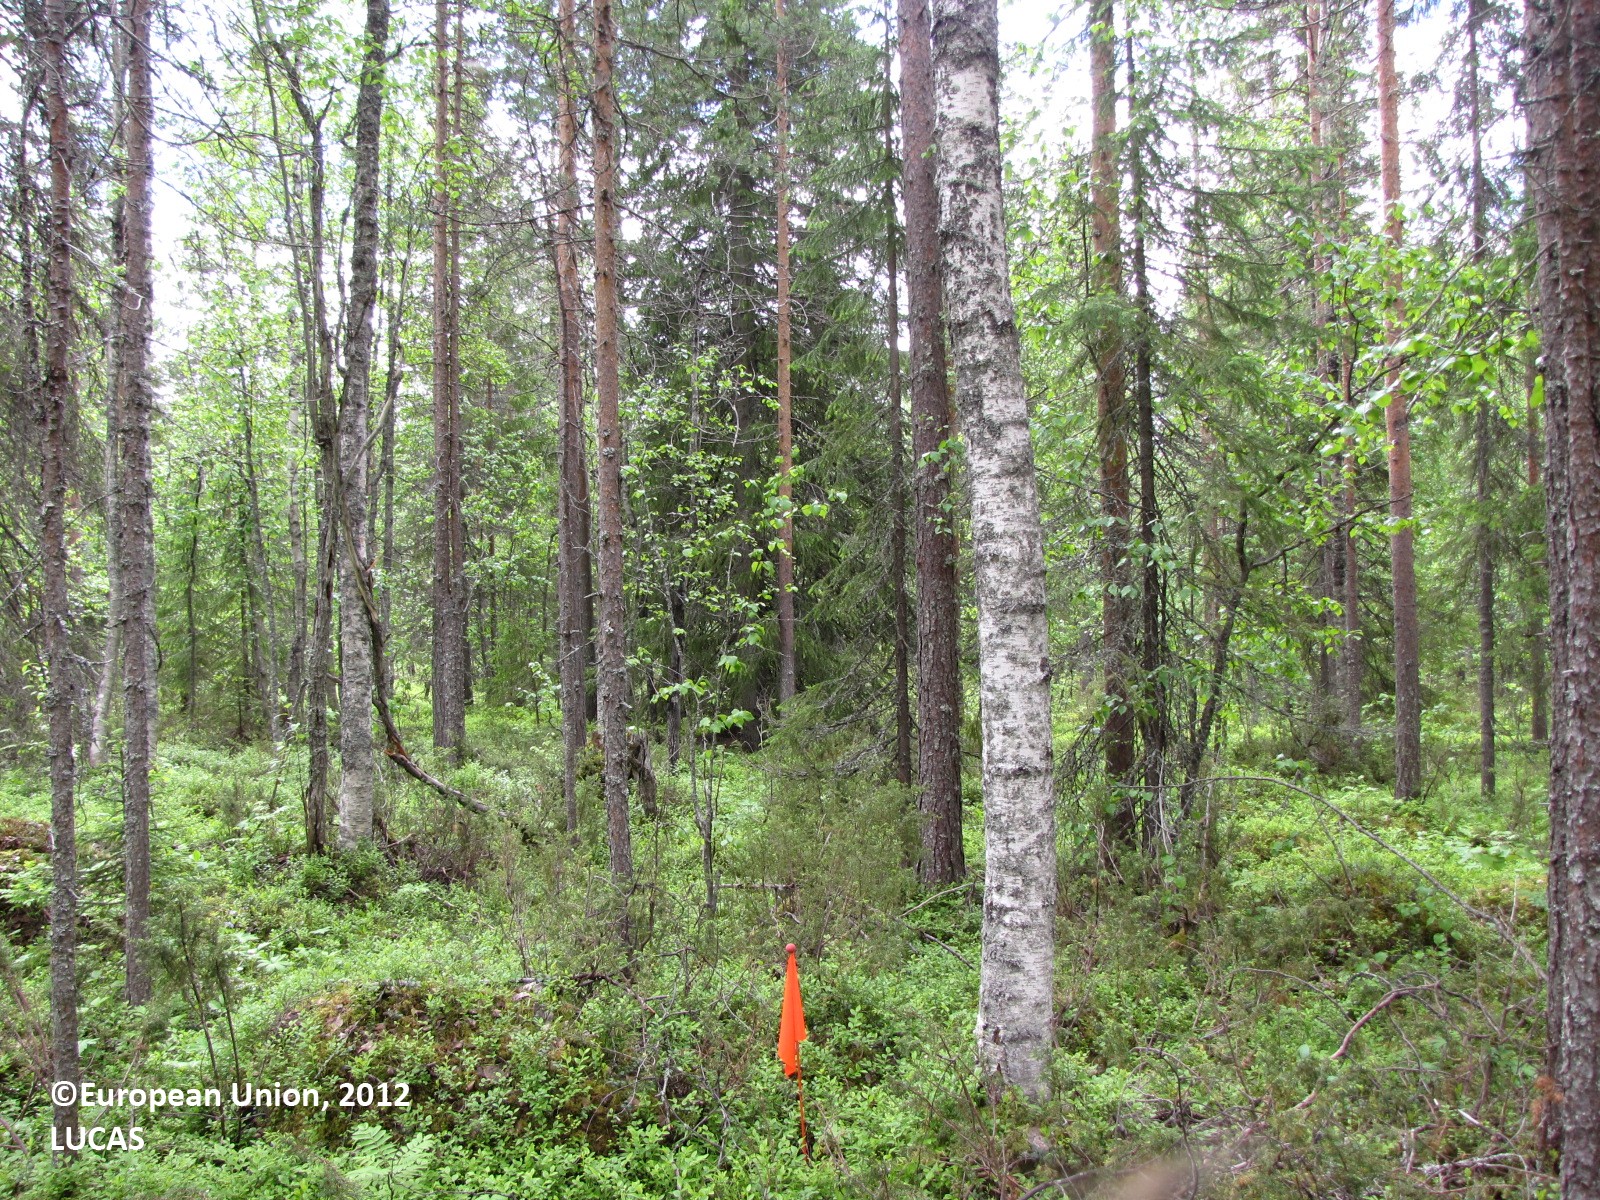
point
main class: Woodland
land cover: Pine dominated mixed woodland
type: boreal forest
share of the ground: 10 - 25 %
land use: Forestry
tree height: > 5 m
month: June
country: FI
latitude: 66.2318
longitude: 24.9768
